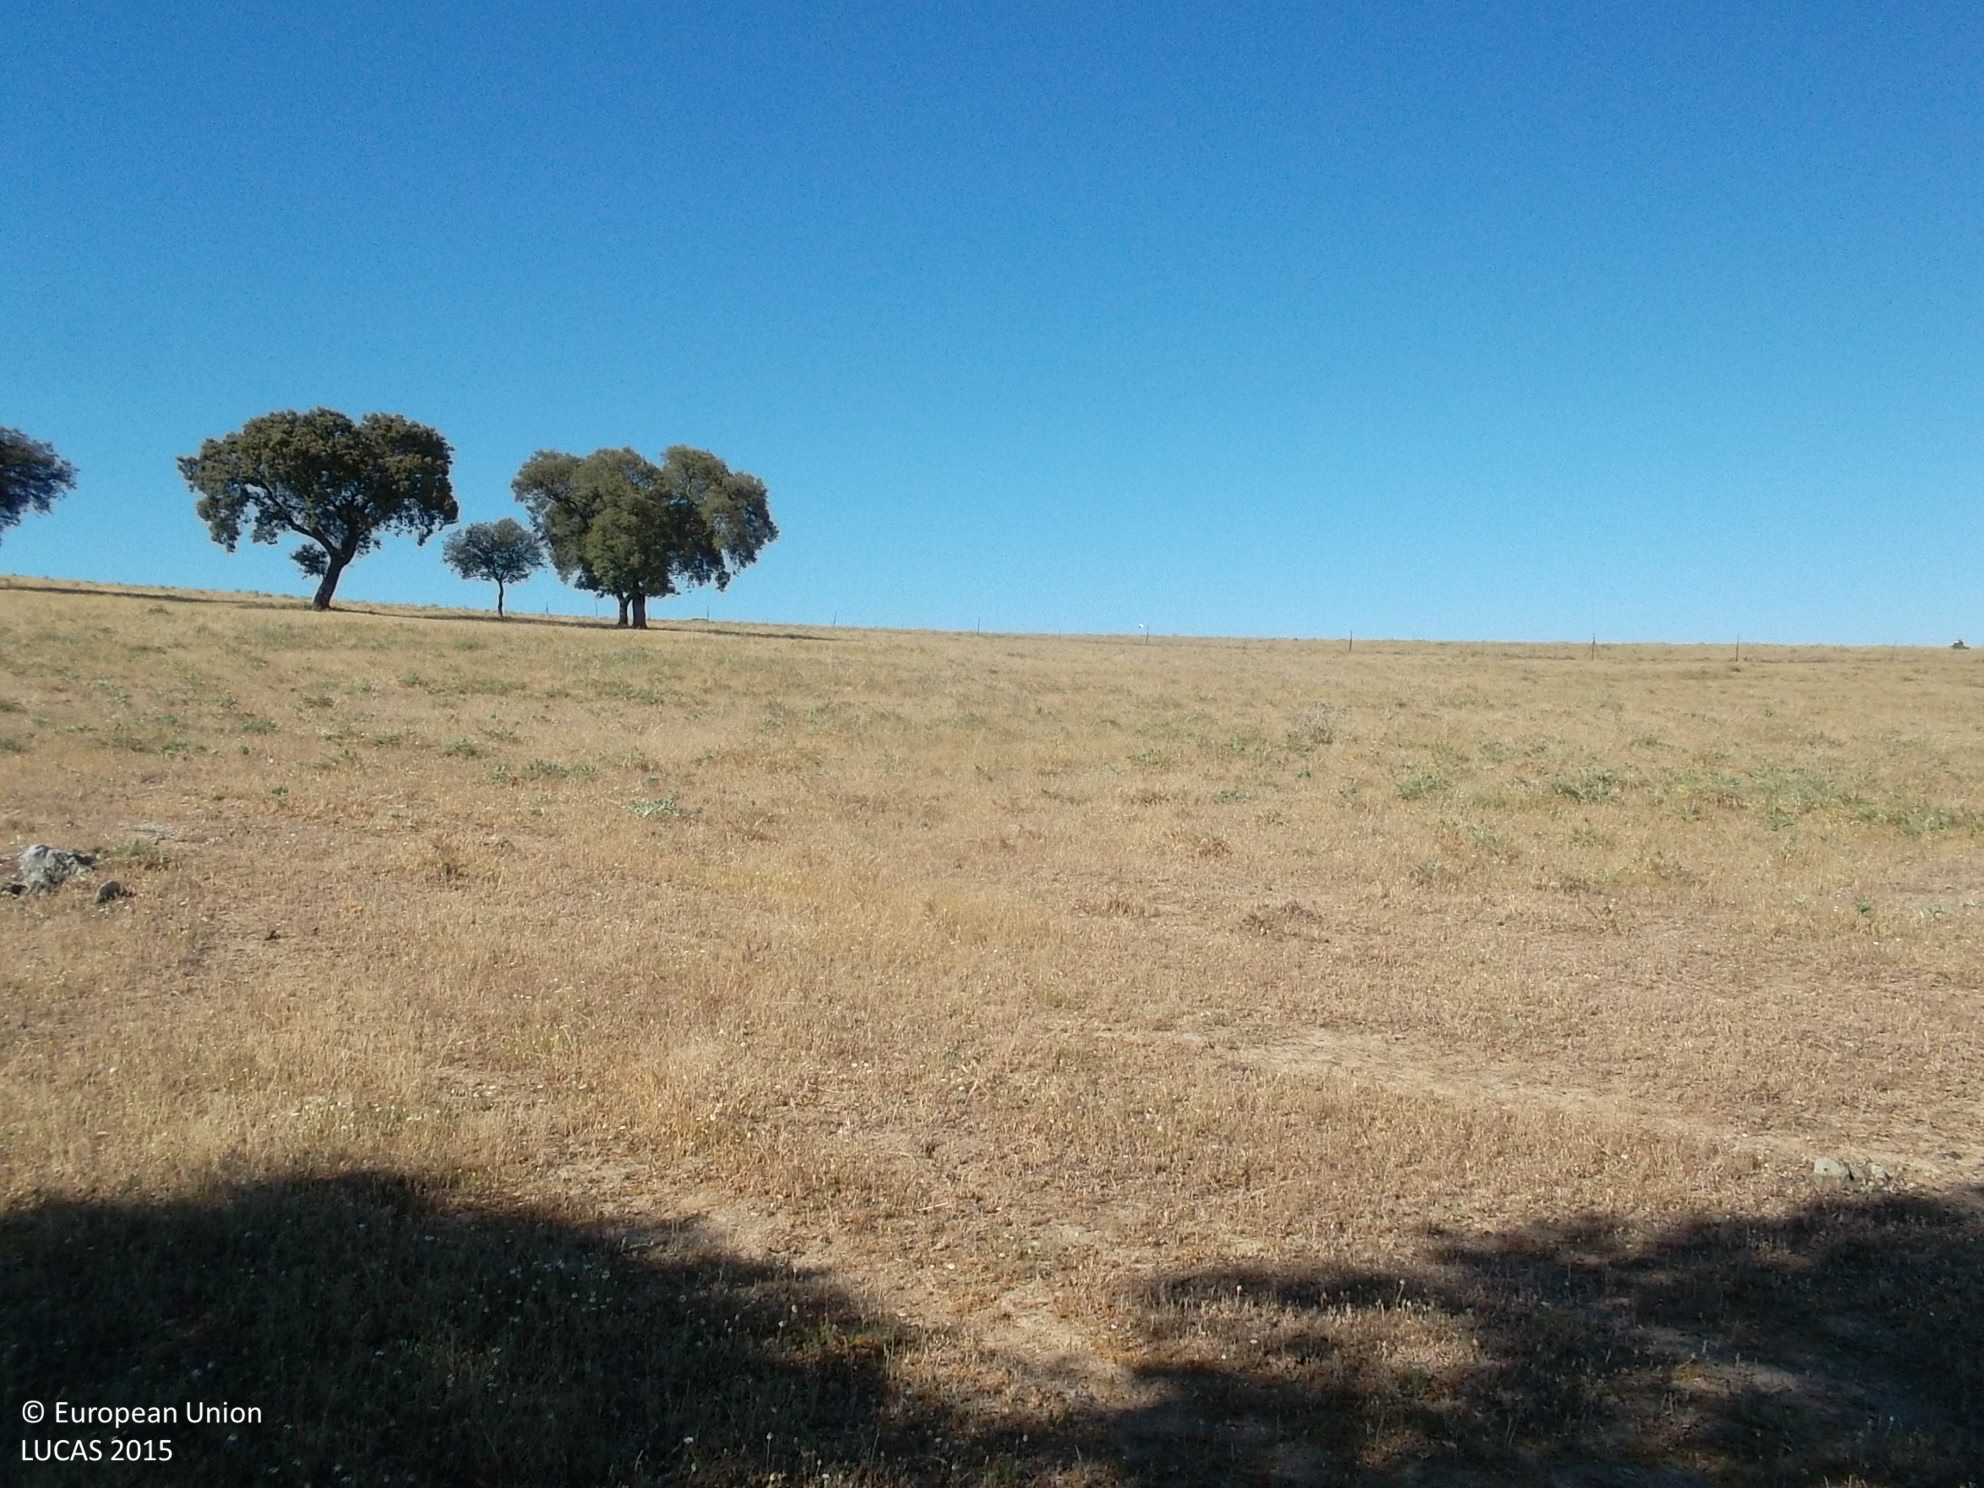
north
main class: Grassland
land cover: Grassland with sparse tree/shrub cover
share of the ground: 50 - 75 %
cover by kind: herbaceous plants 85 %, shrubs 10 %, broadleaved forest trees 5 %
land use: Agriculture (excluding fallow land and kitchen gardens)
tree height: > 5 m
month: May
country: ES
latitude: 38.6455
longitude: -4.4181
